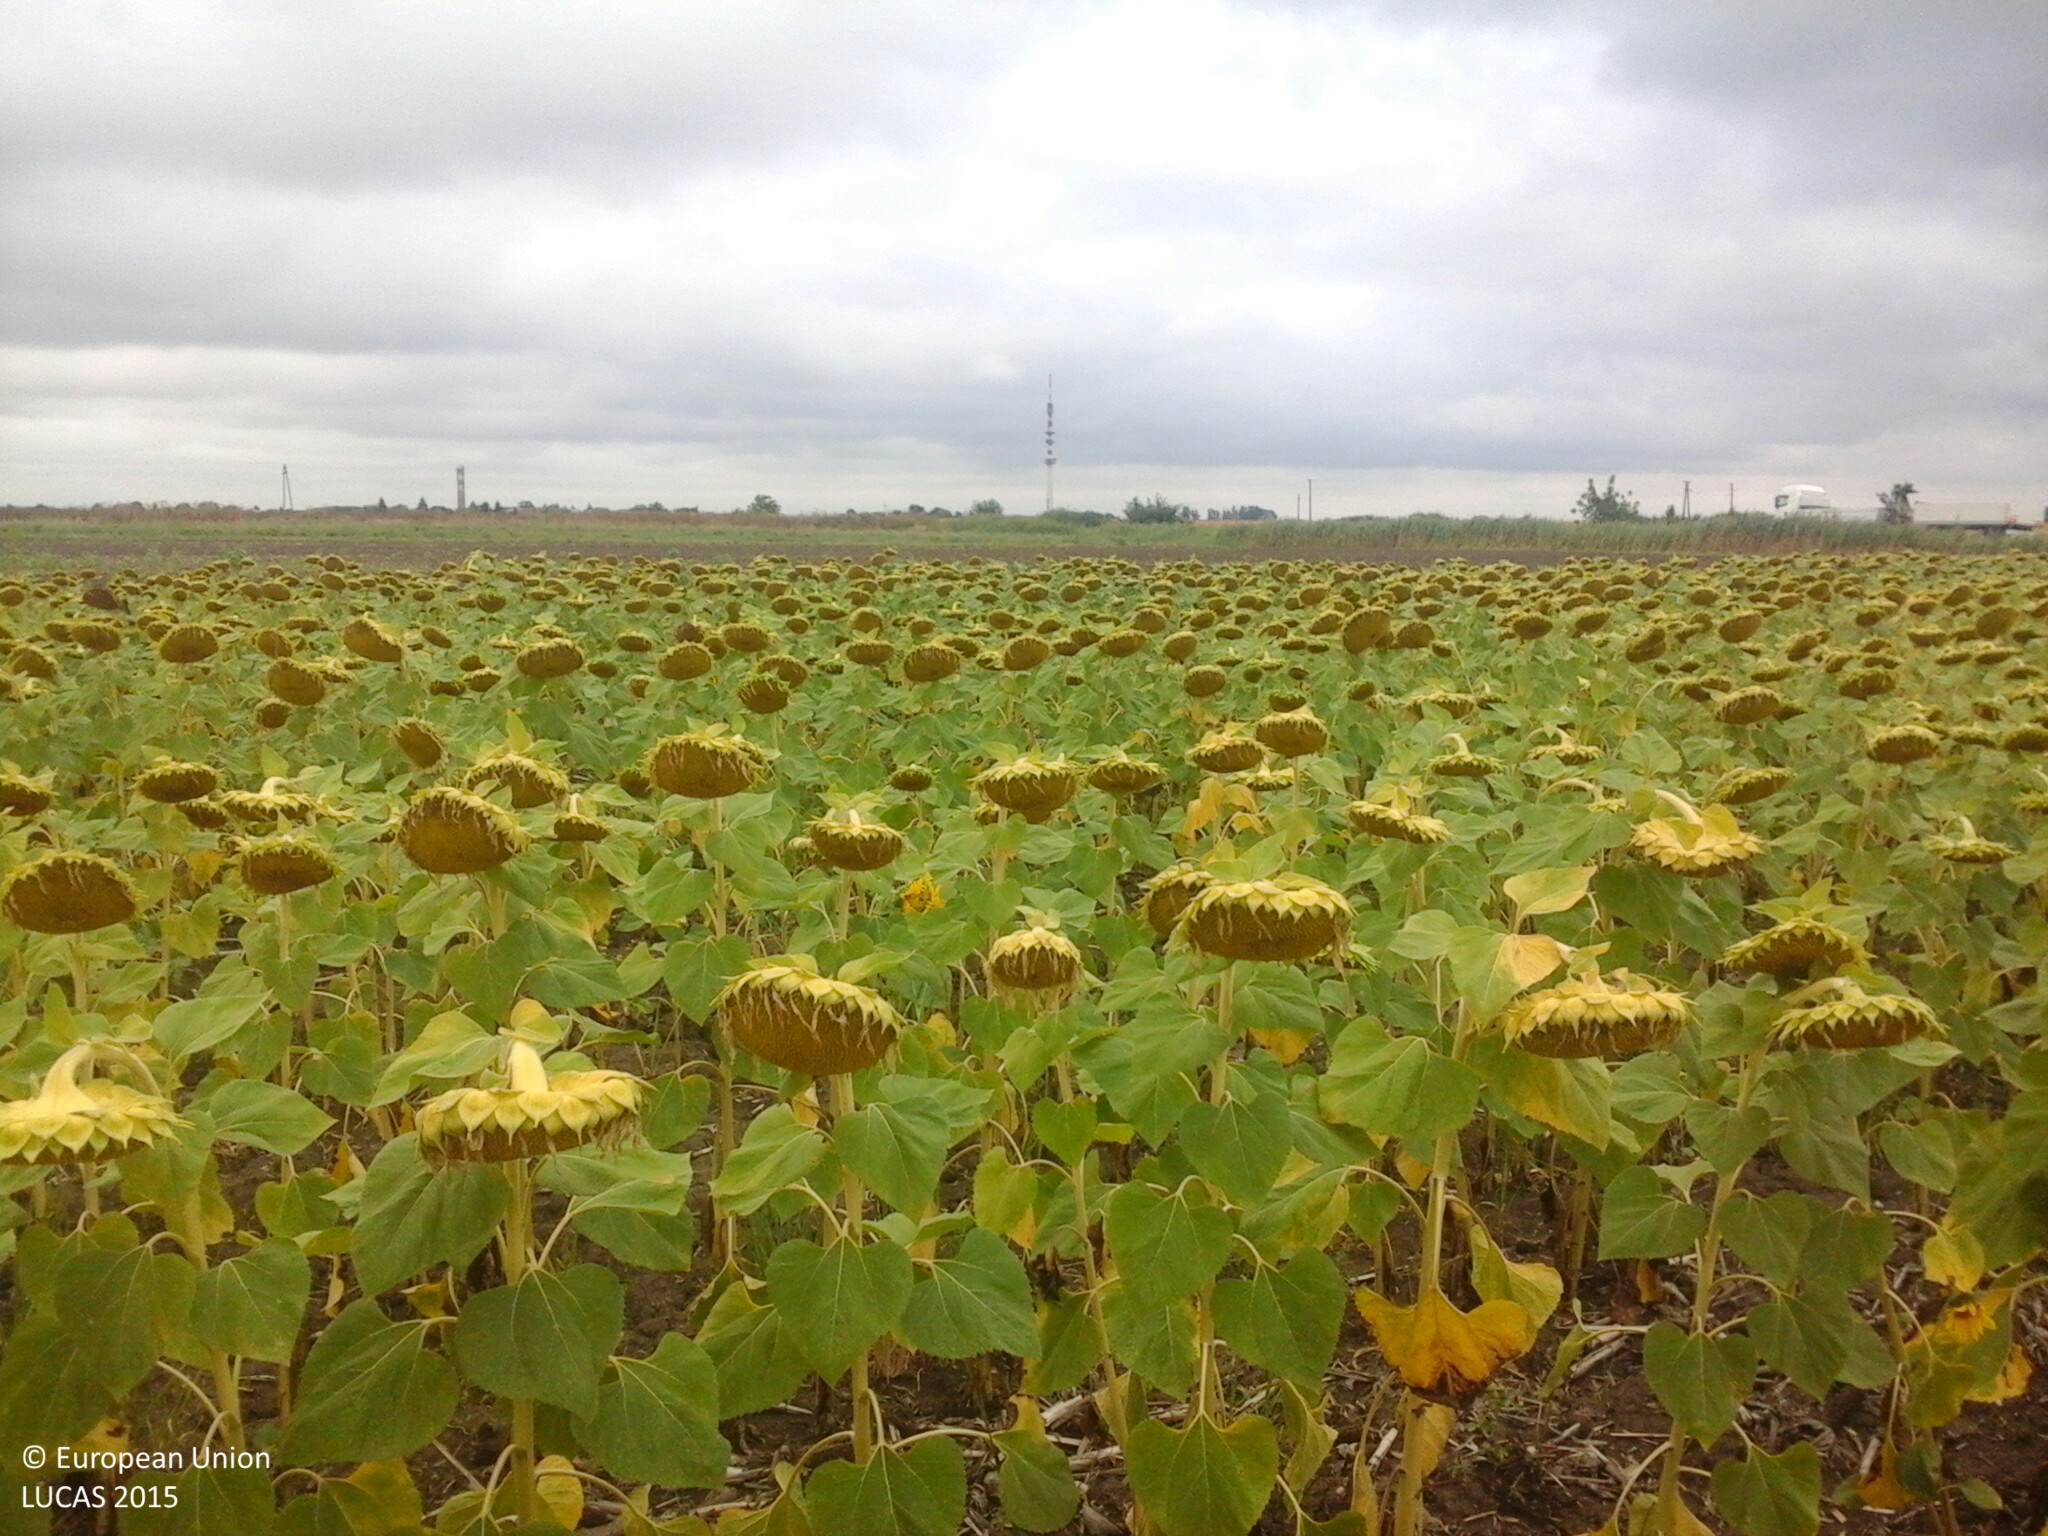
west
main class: Cropland
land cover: Sunflower
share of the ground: 50 - 75 %
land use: Agriculture (excluding fallow land and kitchen gardens)
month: August
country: HU
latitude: 47.0170
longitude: 21.5253
